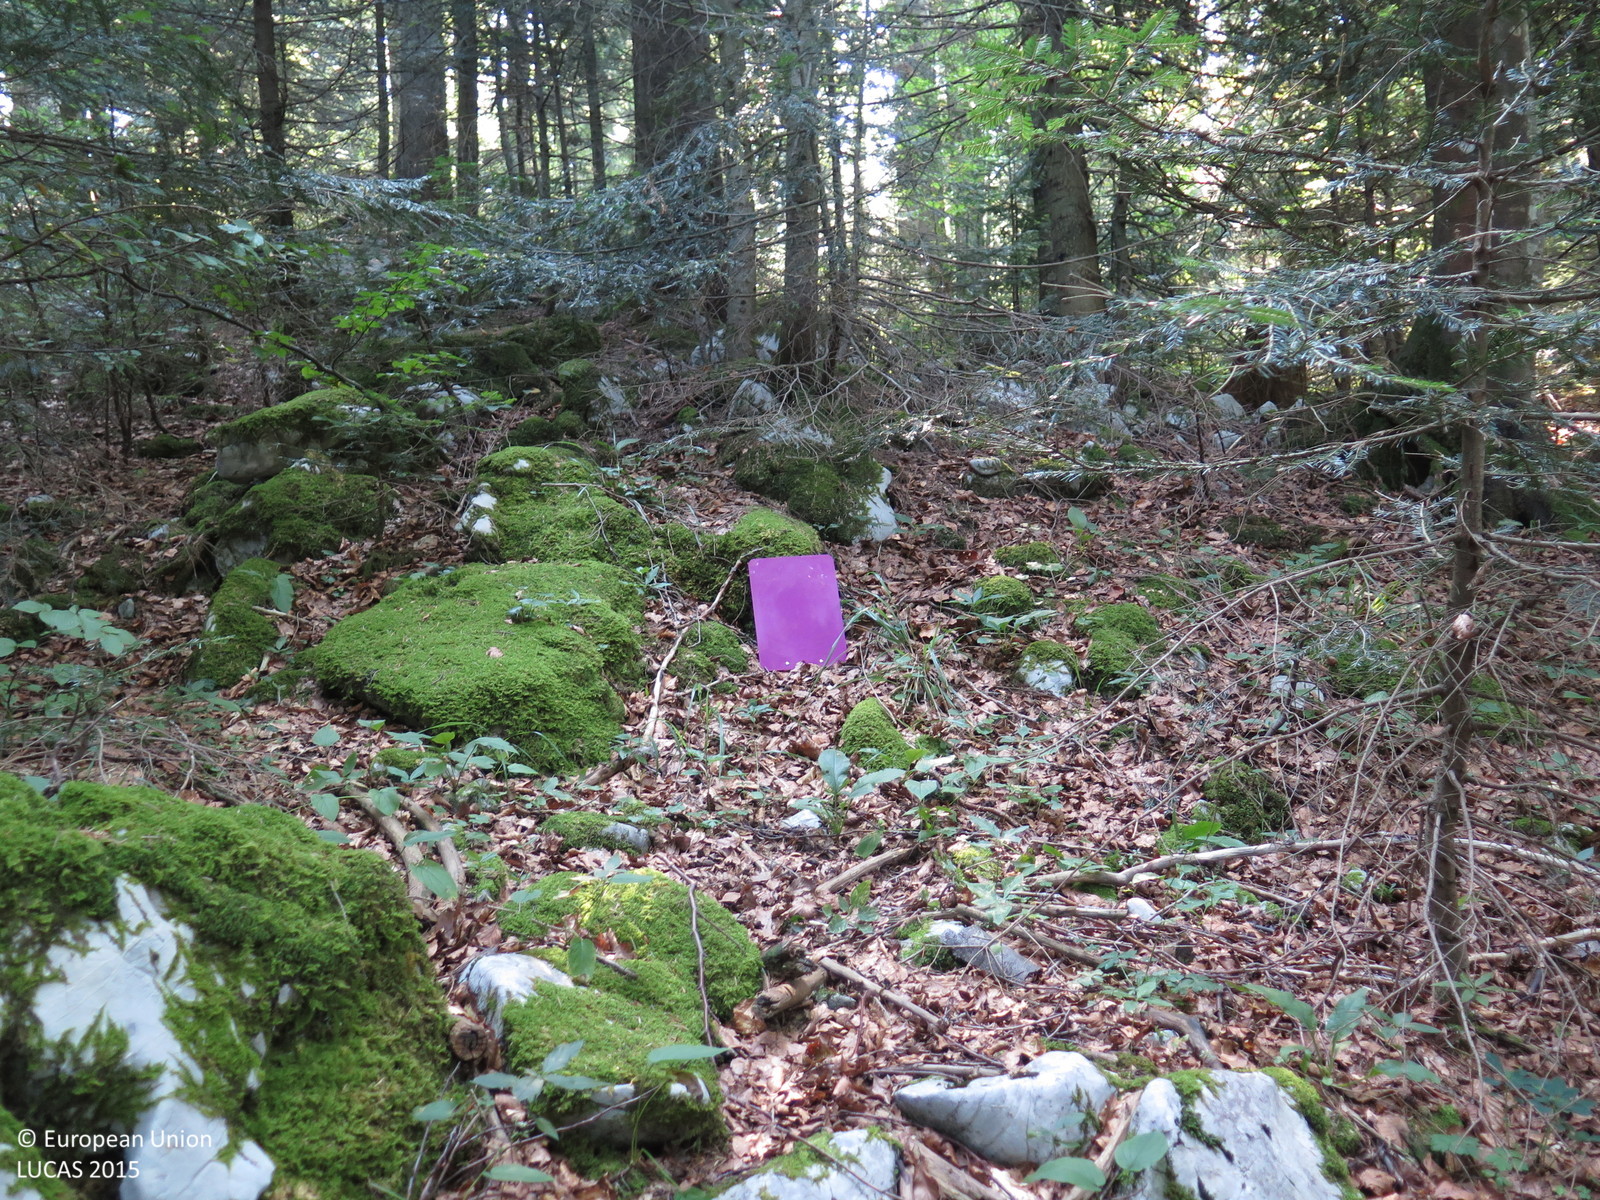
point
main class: Woodland
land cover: Other mixed woodland
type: alpine coniferous forest
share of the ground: > 75 %
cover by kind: coniferous forest trees 75 %, broadleaved forest trees 25 %
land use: Forestry
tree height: > 5 m
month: August
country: HR
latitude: 45.3517
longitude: 14.9605
